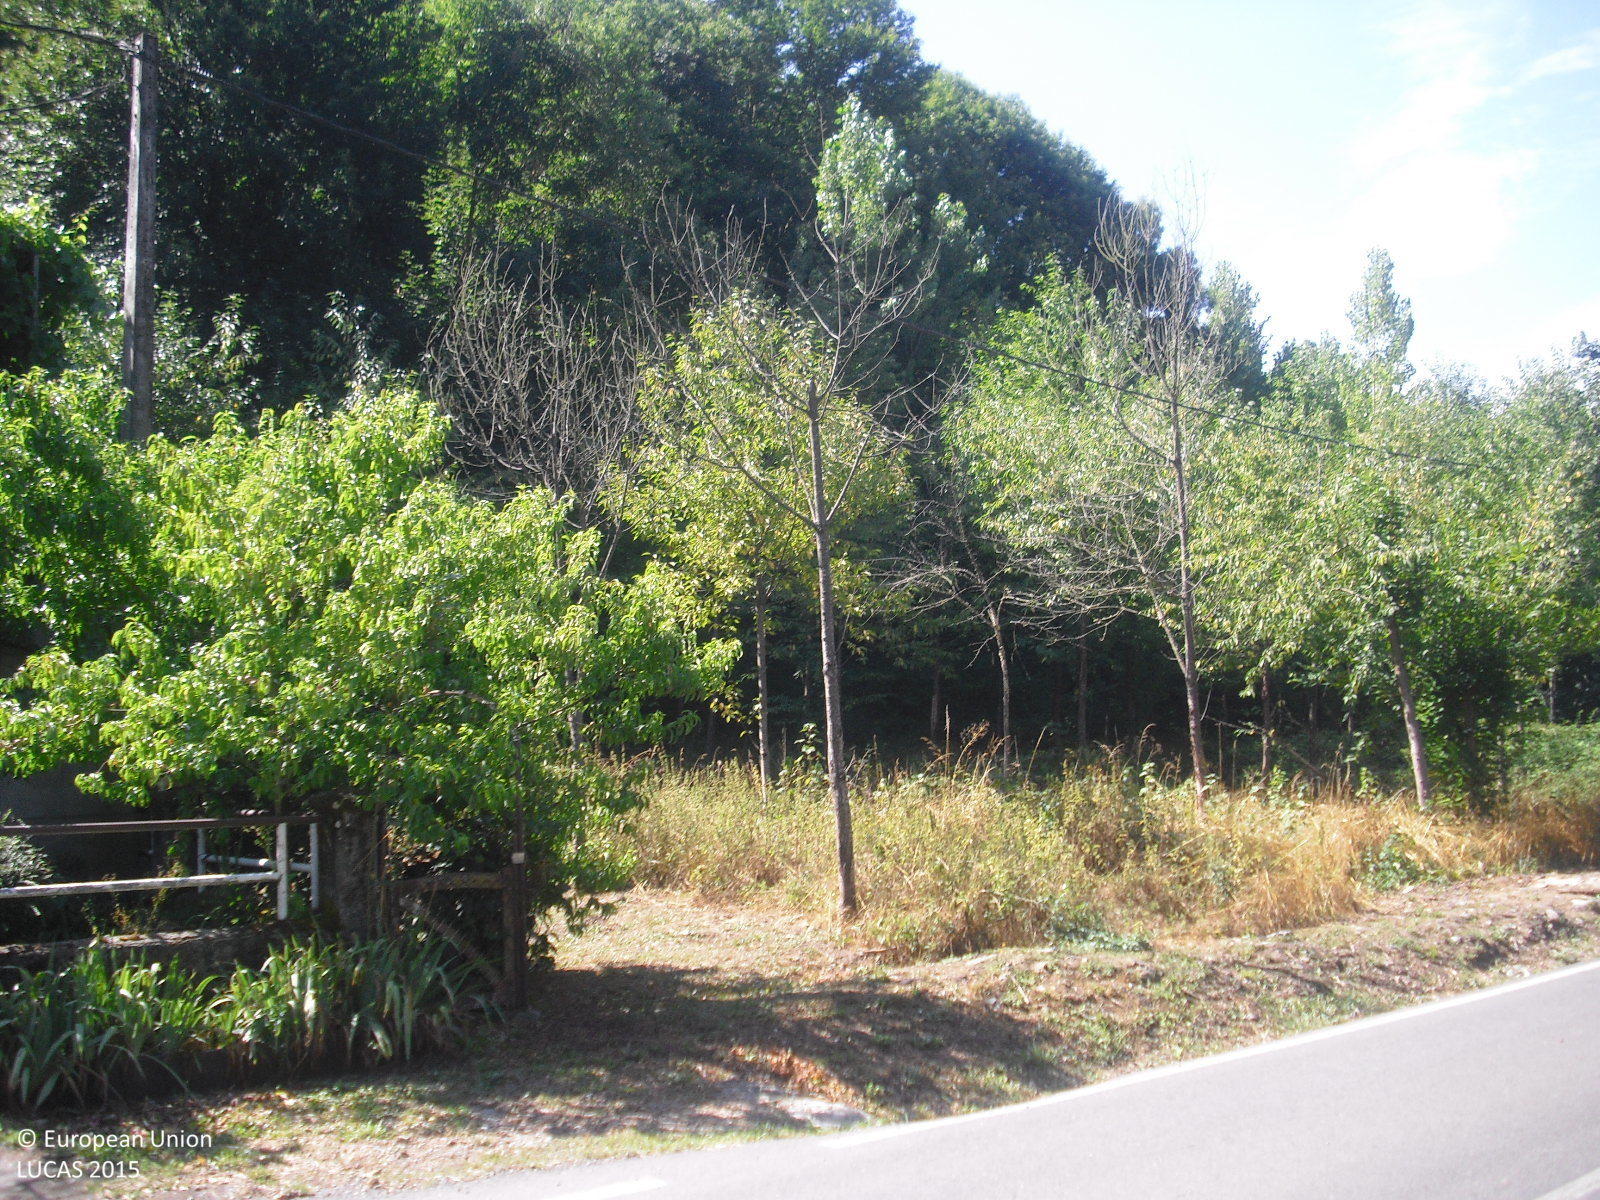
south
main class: Cropland
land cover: Other fruit trees and berries
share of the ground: 50 - 75 %
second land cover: Spontaneously vegetated surfaces
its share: 50 - 75 %
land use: Agriculture (excluding fallow land and kitchen gardens)
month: July
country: ES
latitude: 42.4909
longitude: -7.2291
